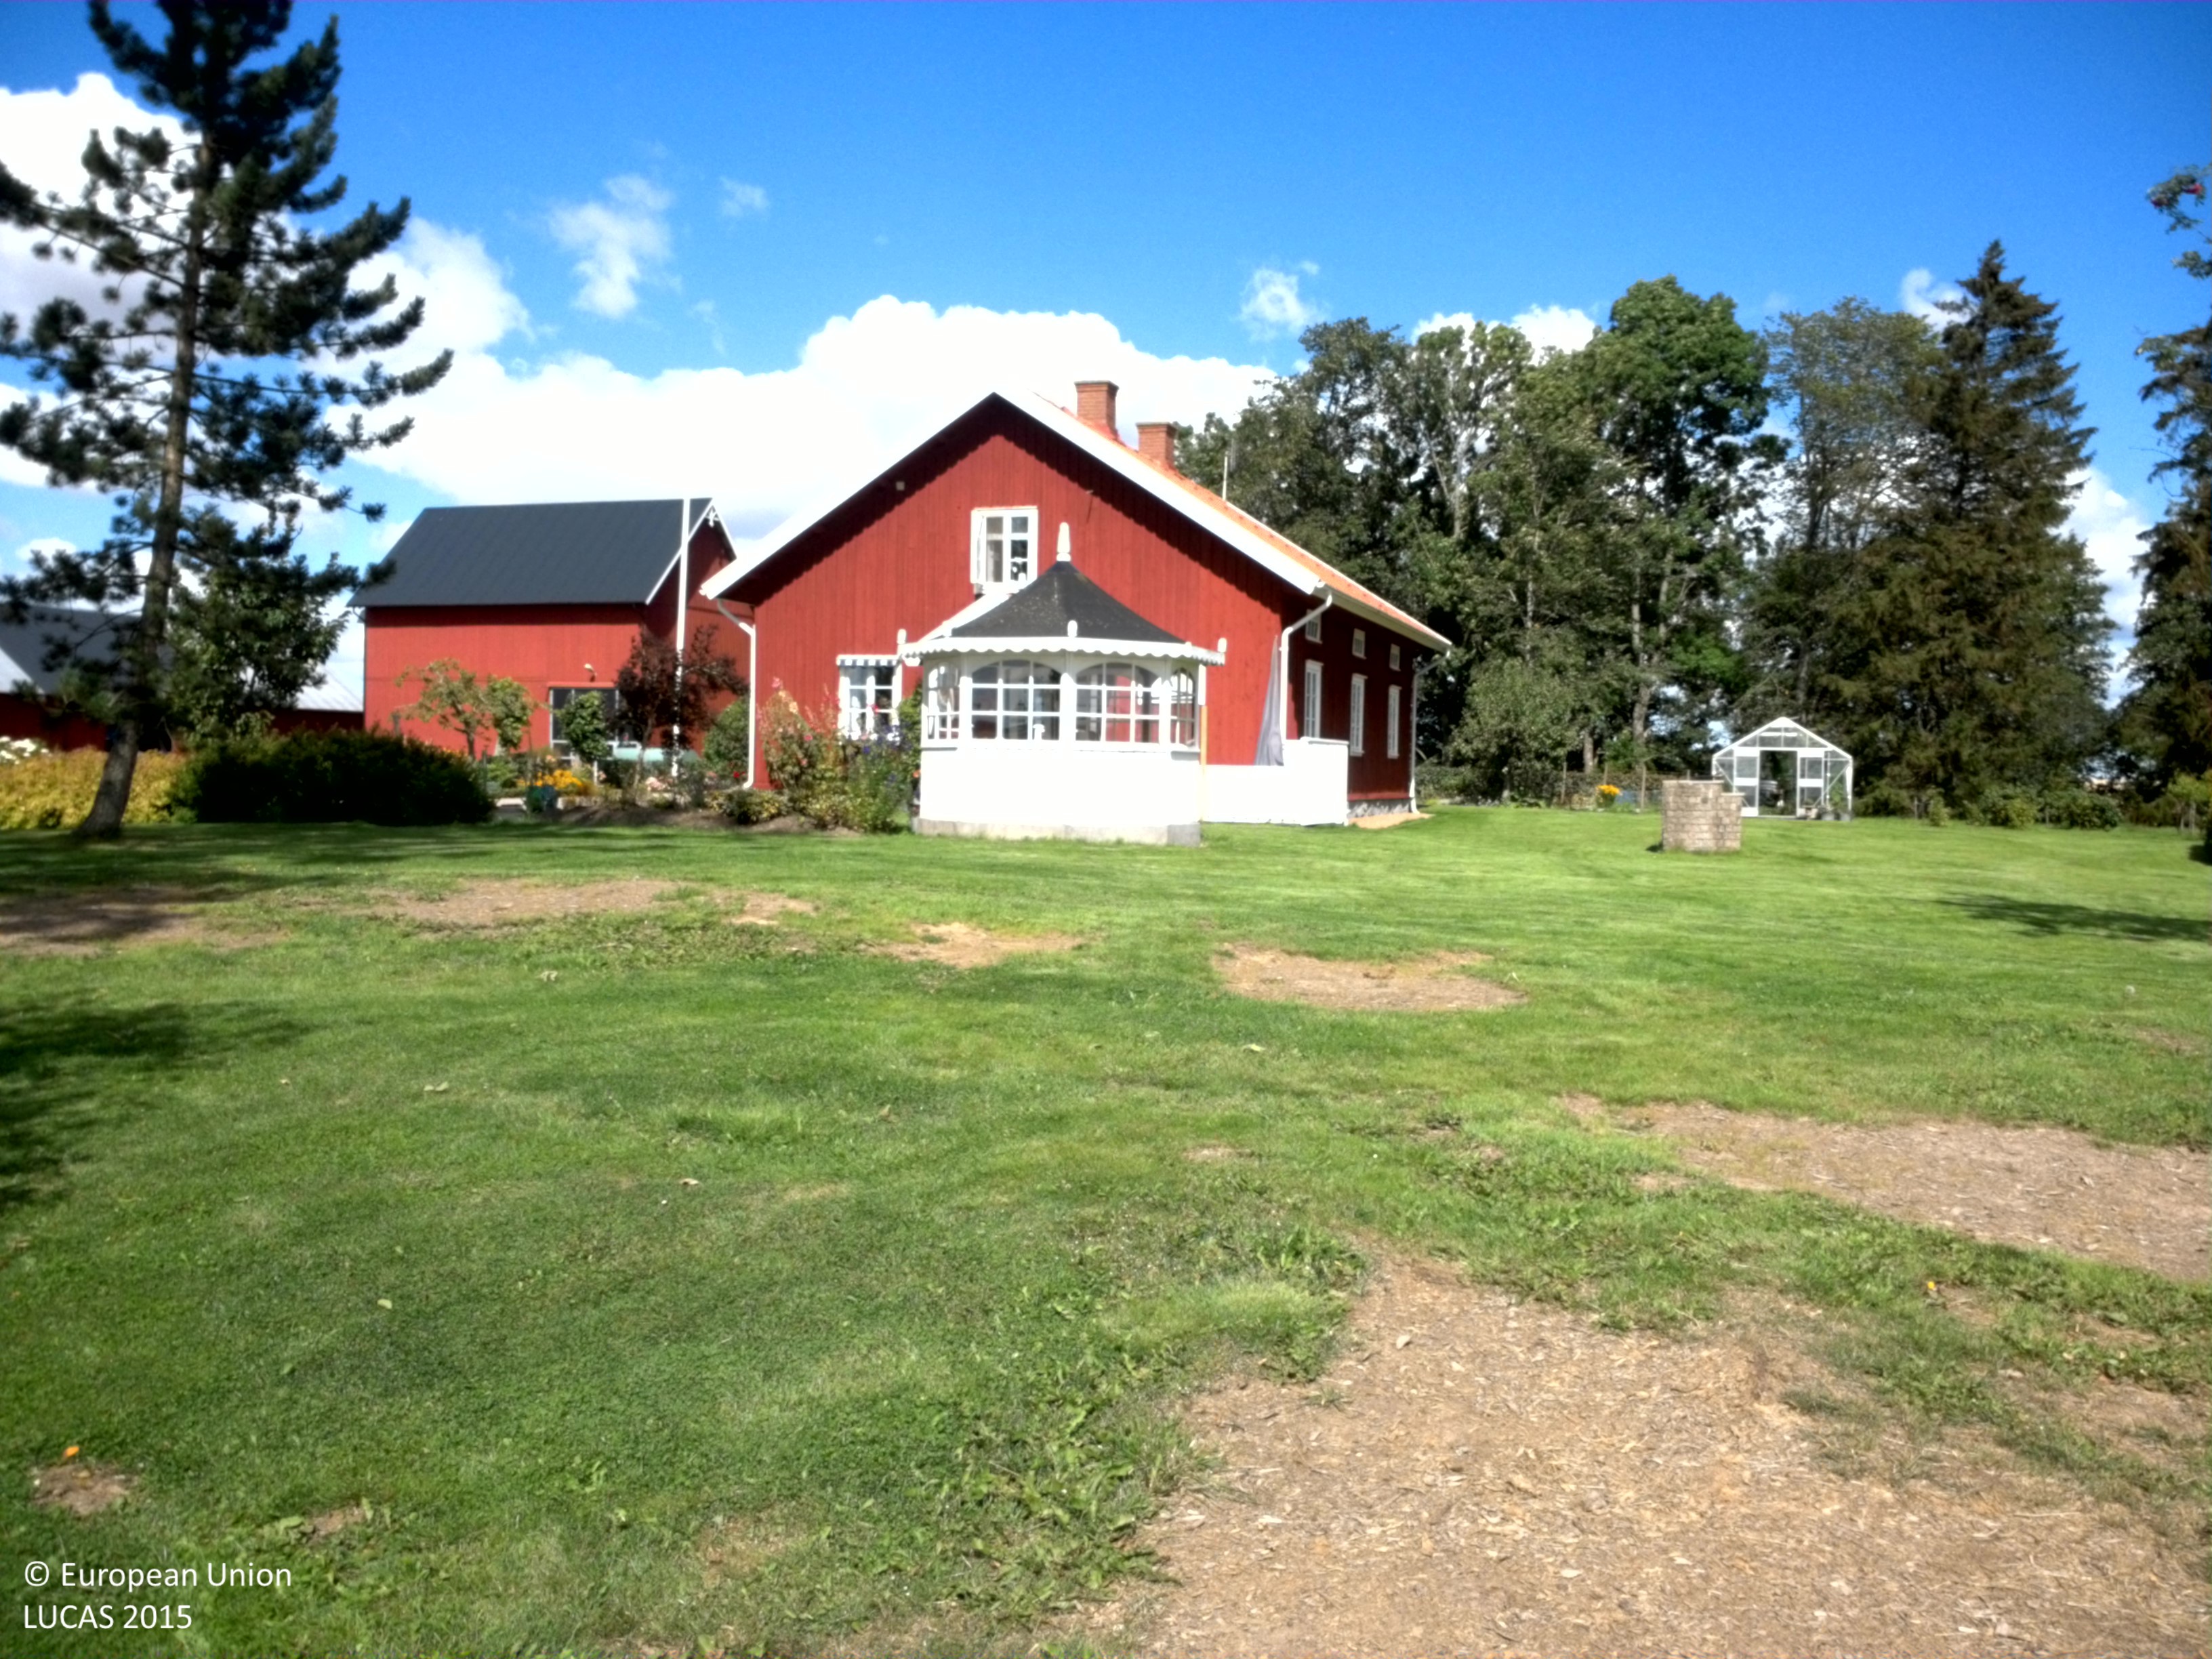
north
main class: Cropland
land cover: Common wheat
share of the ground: > 75 %
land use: Agriculture (excluding fallow land and kitchen gardens)
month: August
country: SE
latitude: 58.2523
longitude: 13.2490
